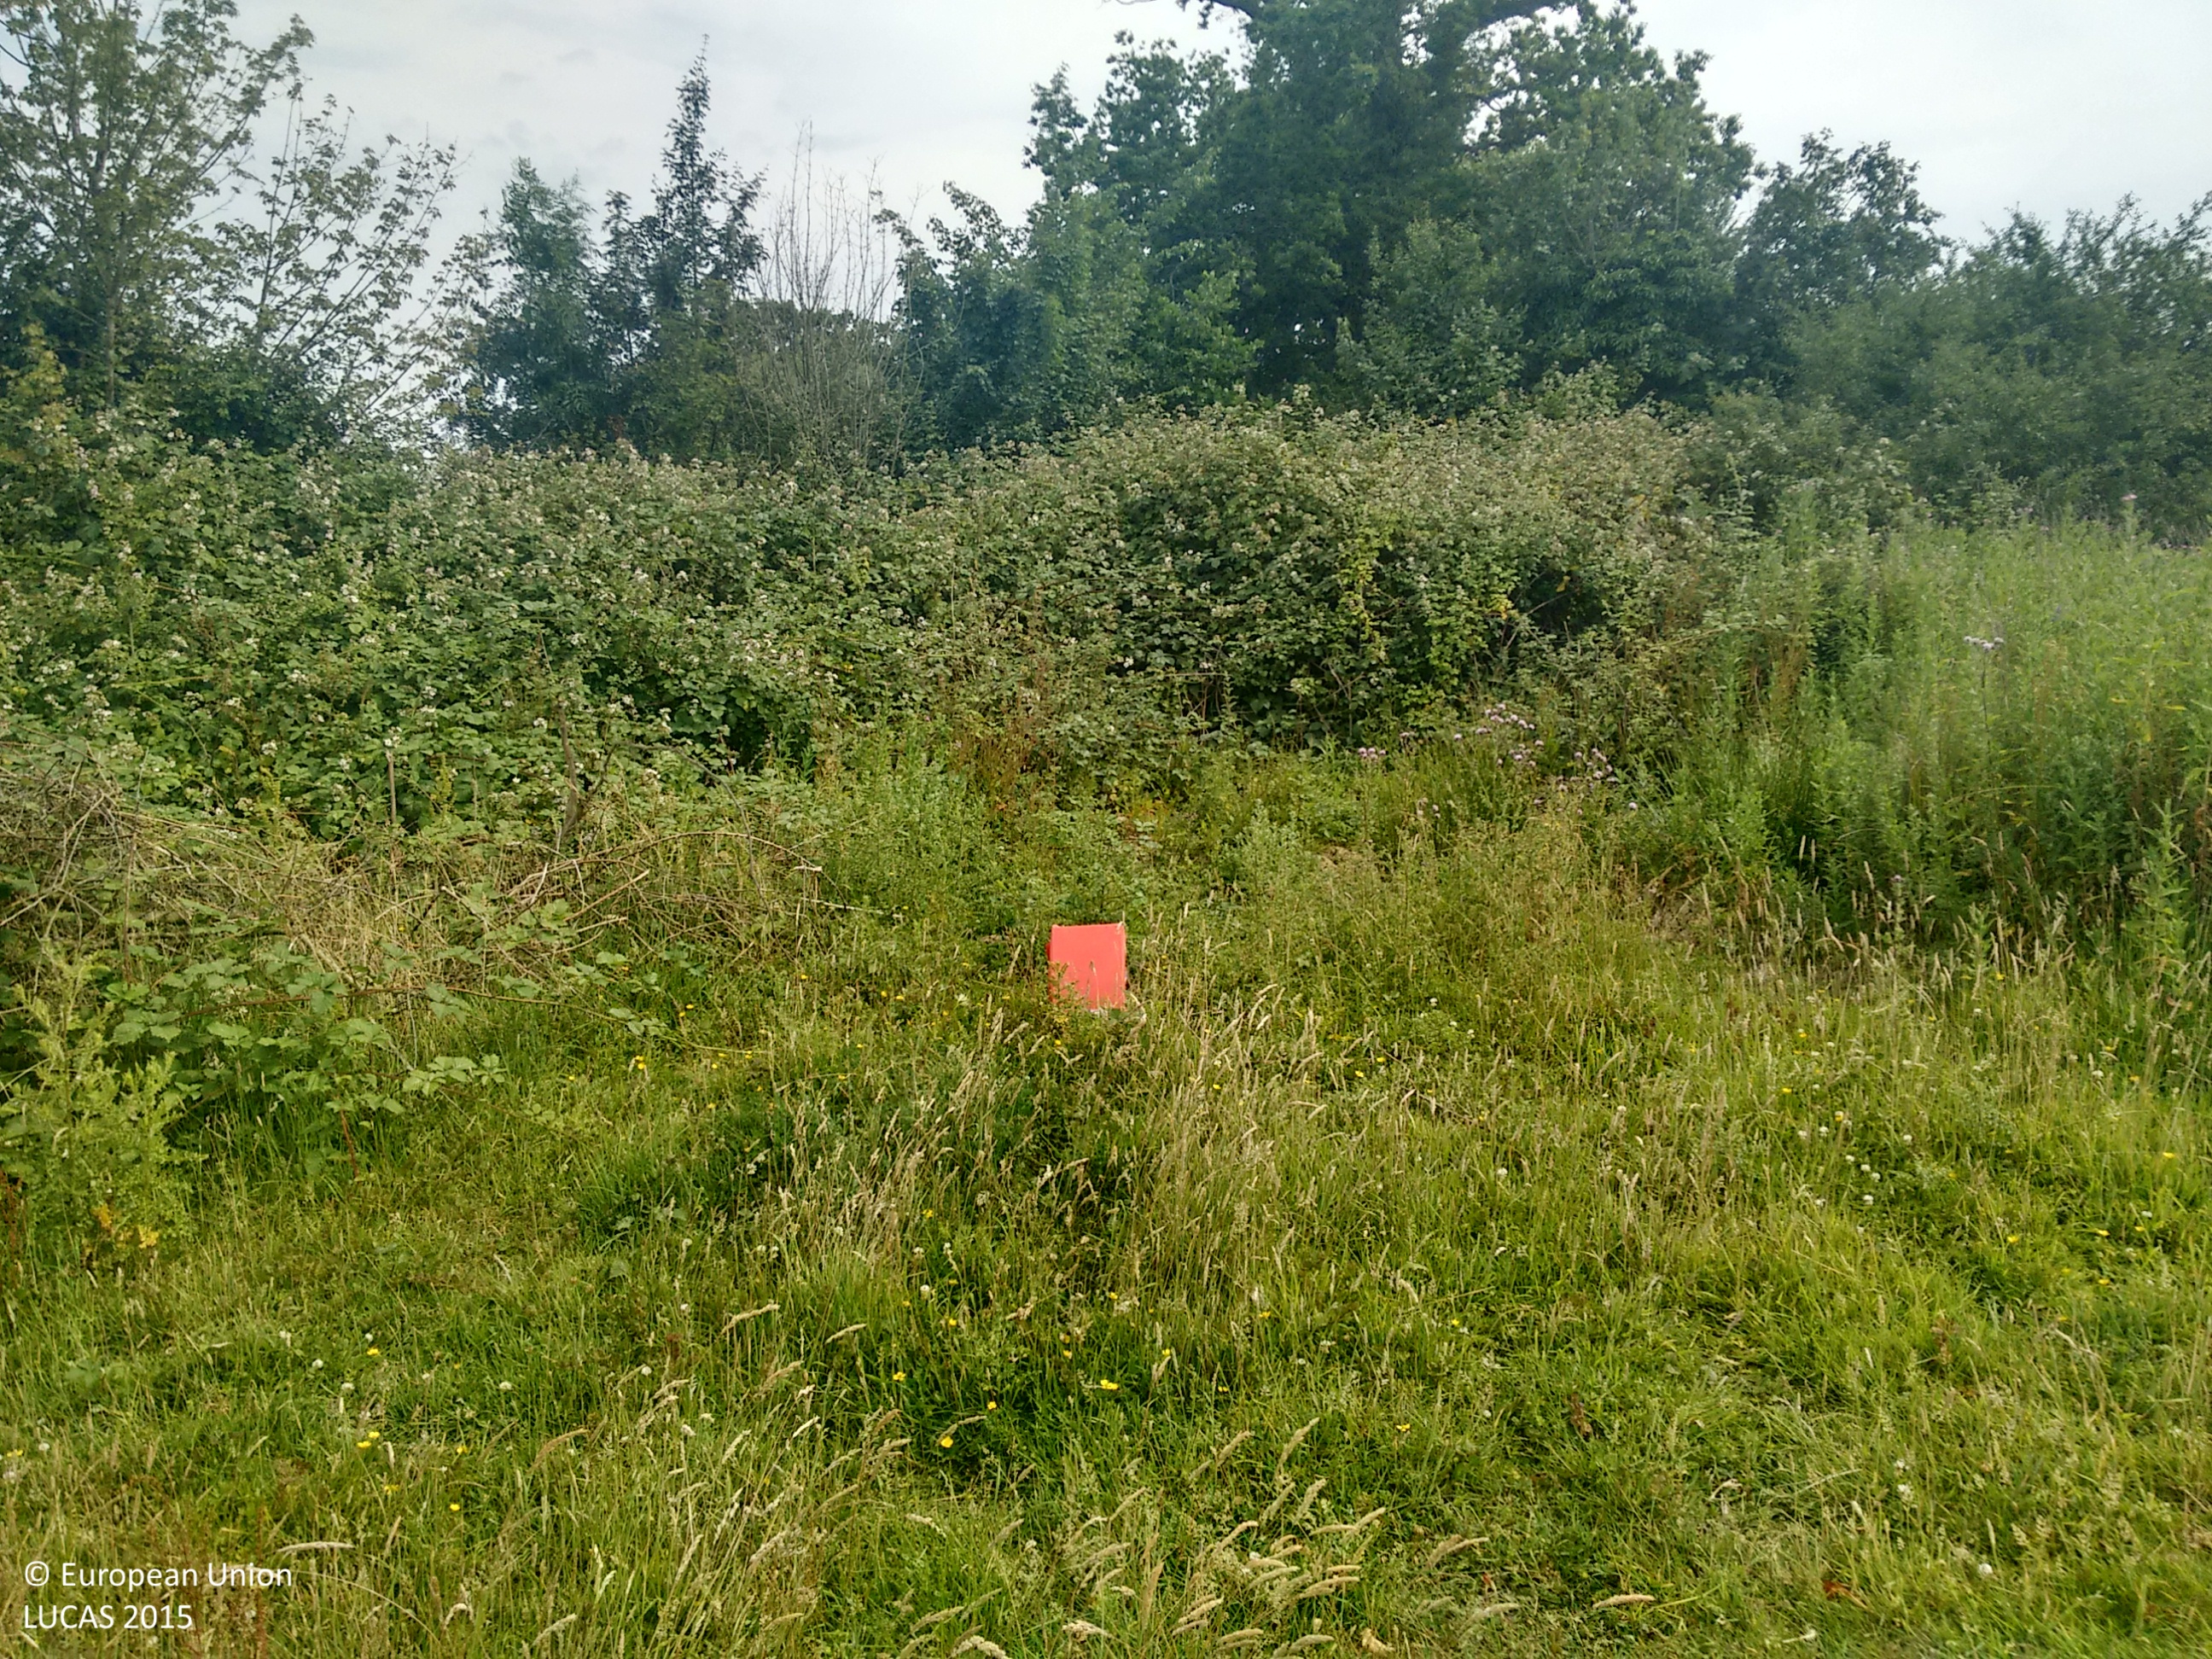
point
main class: Shrubland
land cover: Shrubland with sparse tree cover
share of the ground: > 75 %
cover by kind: shrubs 75 %, herbaceous plants 20 %, broadleaved forest trees 5 %
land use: Semi-natural and natural areas not in use
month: July
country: GB
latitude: 51.1930
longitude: -0.2090
